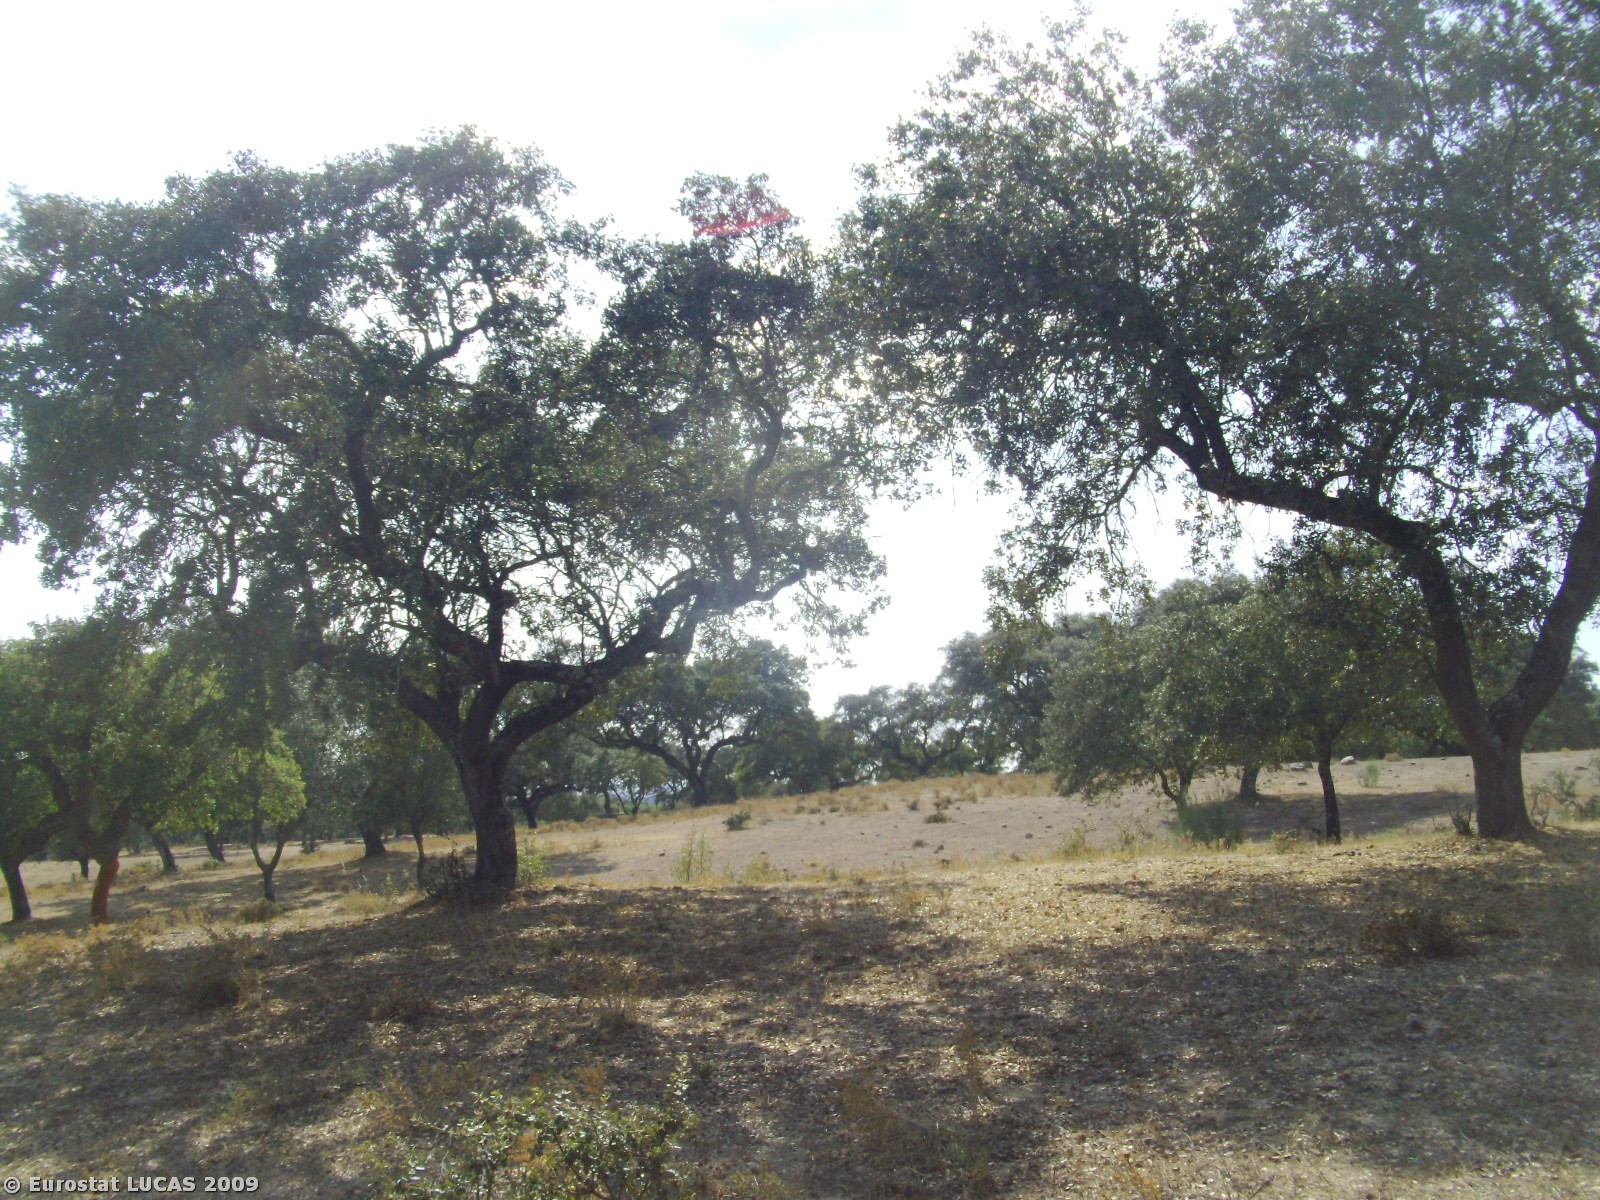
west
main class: Woodland
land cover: Broadleaved woodland
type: broadleaved evergreen forest
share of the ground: 50 - 75 %
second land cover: Spontaneously vegetated surfaces
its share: < 10 %
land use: Forestry
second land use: Fallow land
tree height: > 5 m
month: August
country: PT
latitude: 38.3787
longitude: -7.9282
